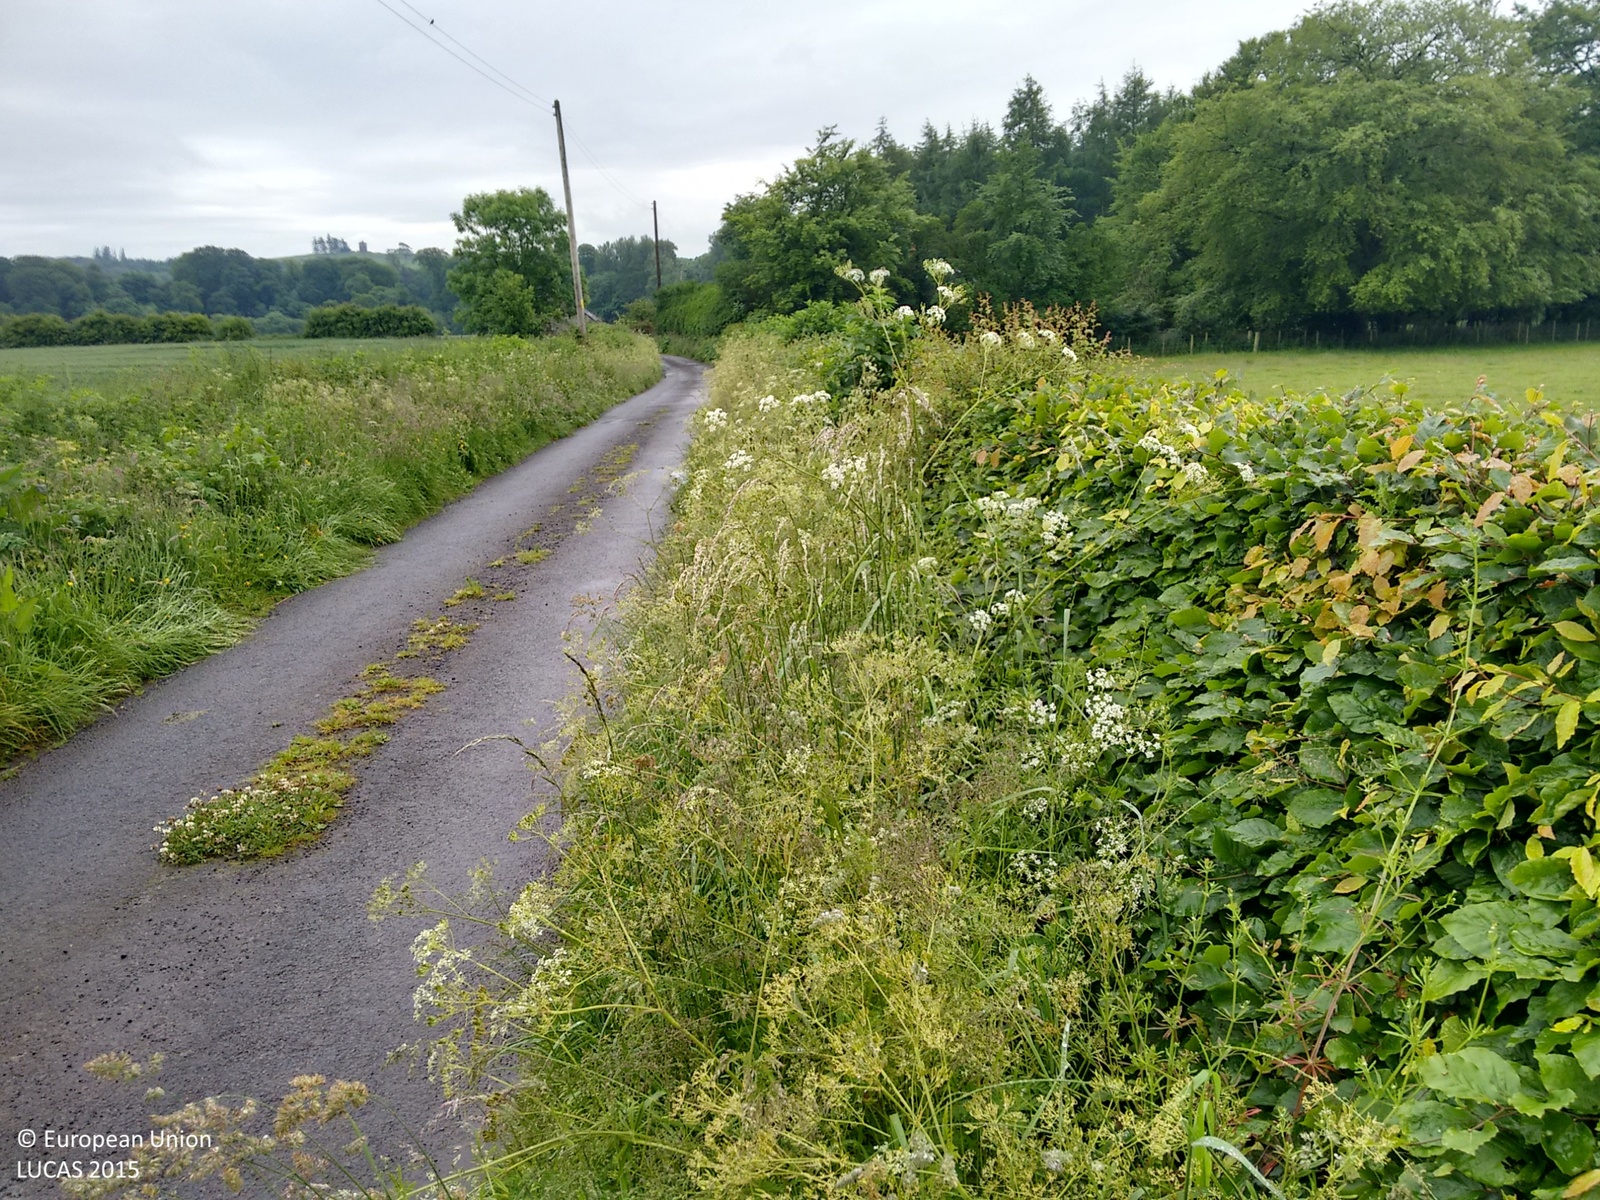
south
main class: Grassland
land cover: Grassland without tree/shrub cover
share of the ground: > 75 %
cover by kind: herbaceous plants 100 %
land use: Agriculture (excluding fallow land and kitchen gardens)
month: June
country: GB
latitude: 55.0496
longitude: -3.3348
